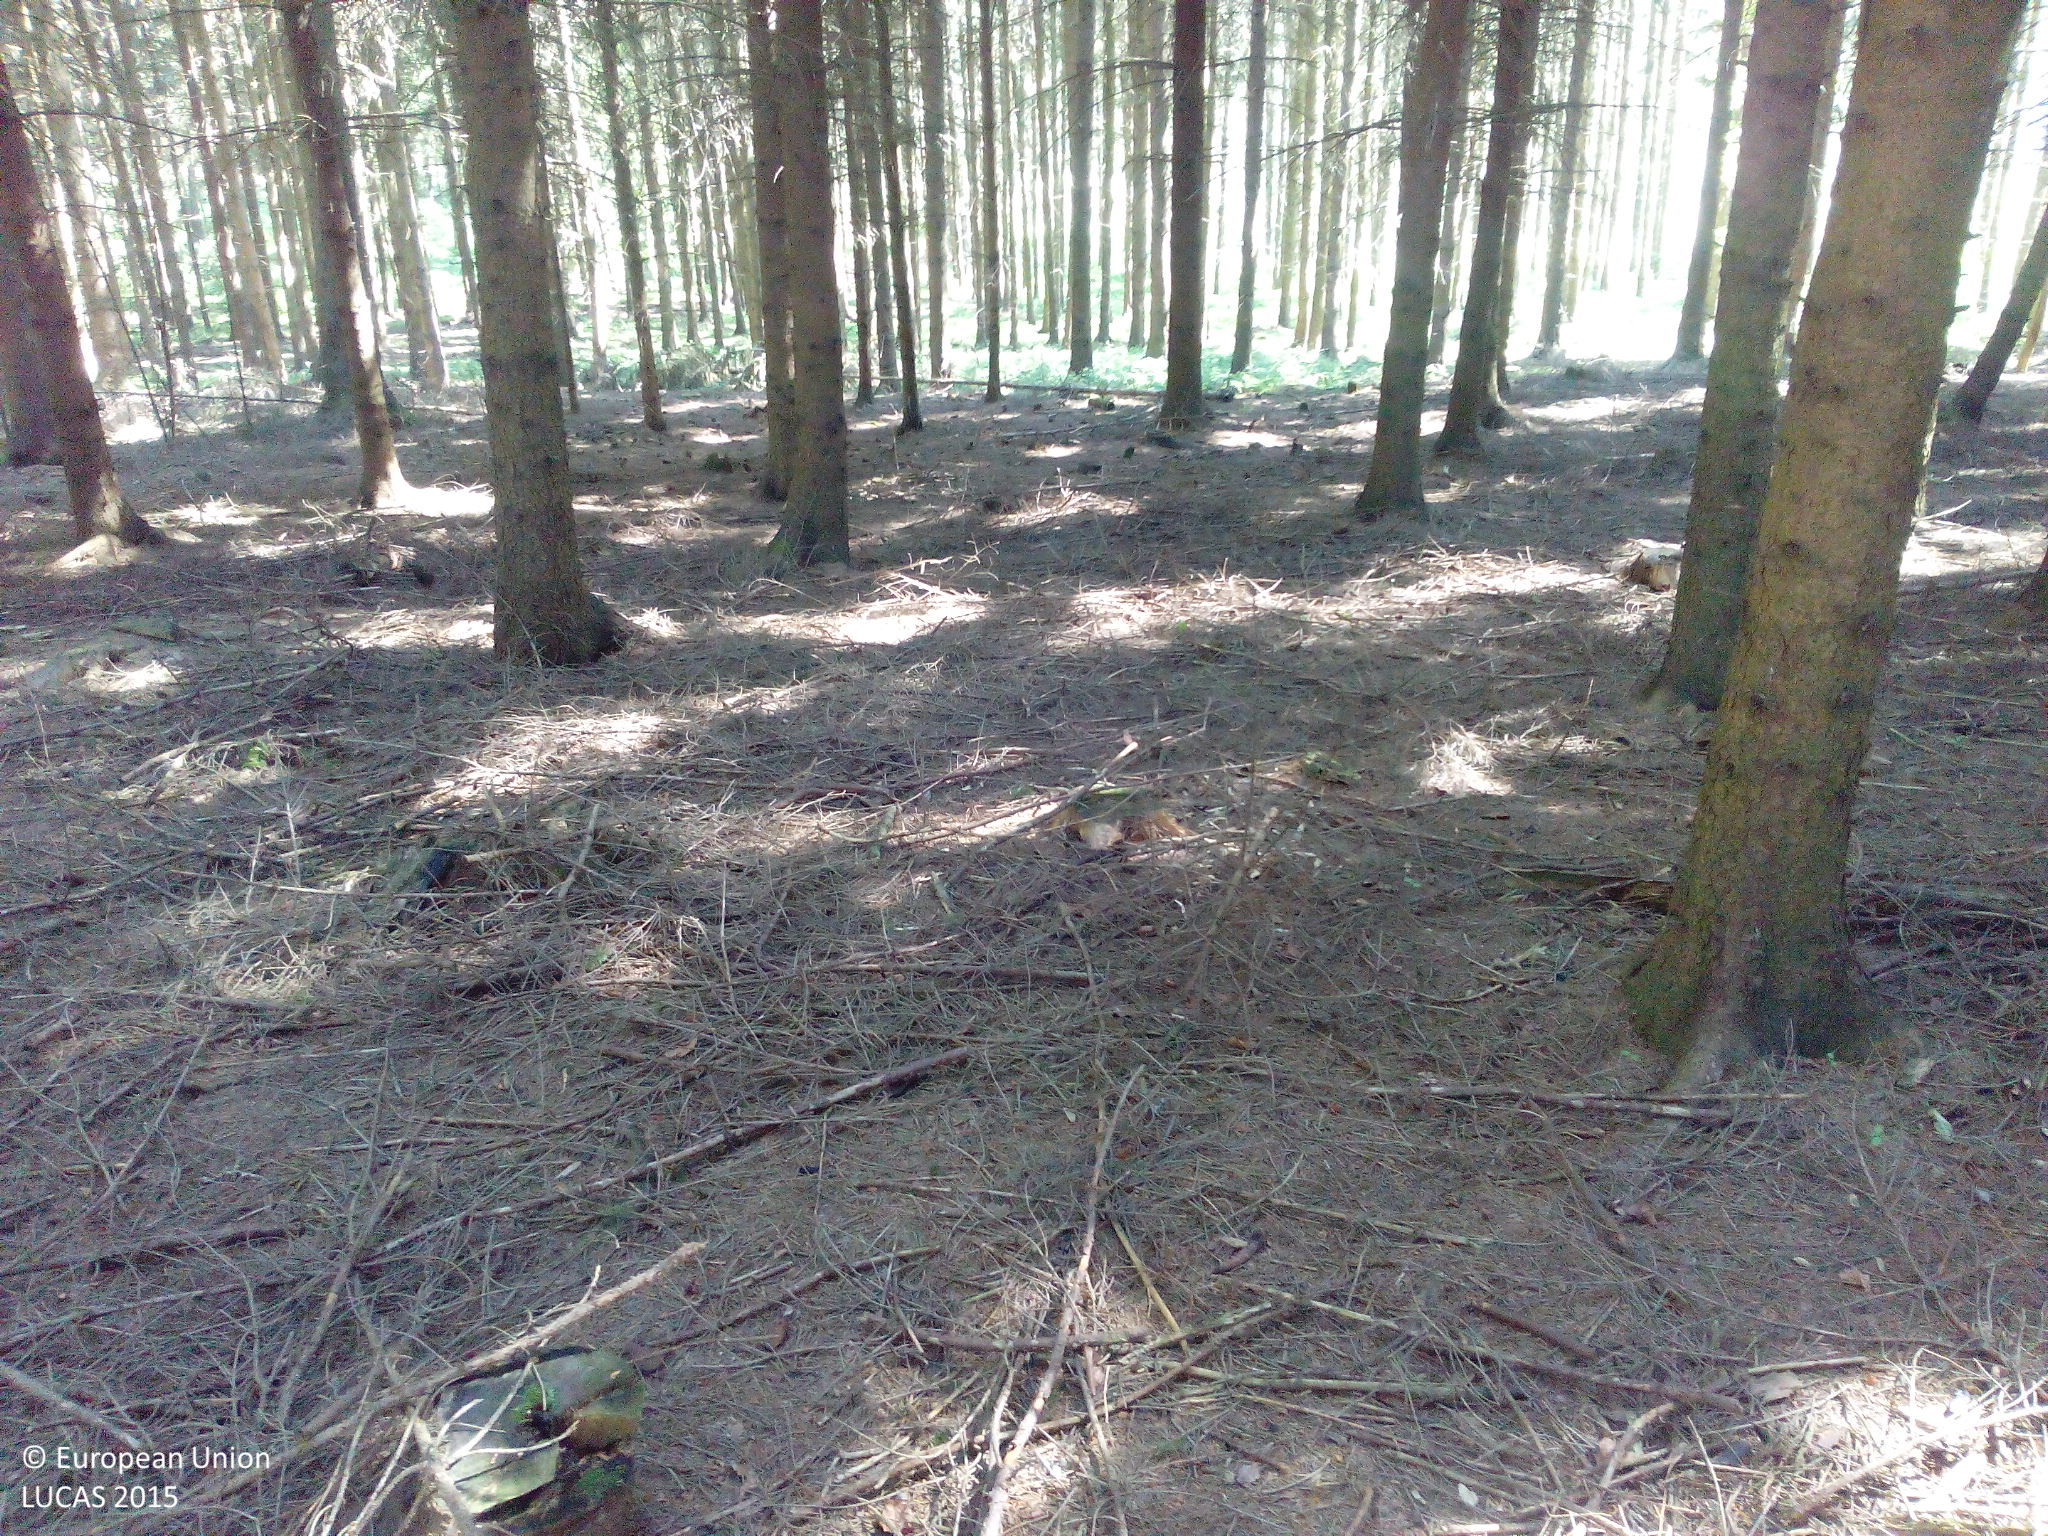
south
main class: Woodland
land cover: Spruce dominated coniferous woodland
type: hemiboreal forest and nemoral coniferous forest and mixed broadleaved-coniferous forest
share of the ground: > 75 %
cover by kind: coniferous forest trees 95 %, unconsolidated bare surface 5 %
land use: Forestry
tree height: > 5 m
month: June
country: DE
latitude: 48.6540
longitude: 12.0762
